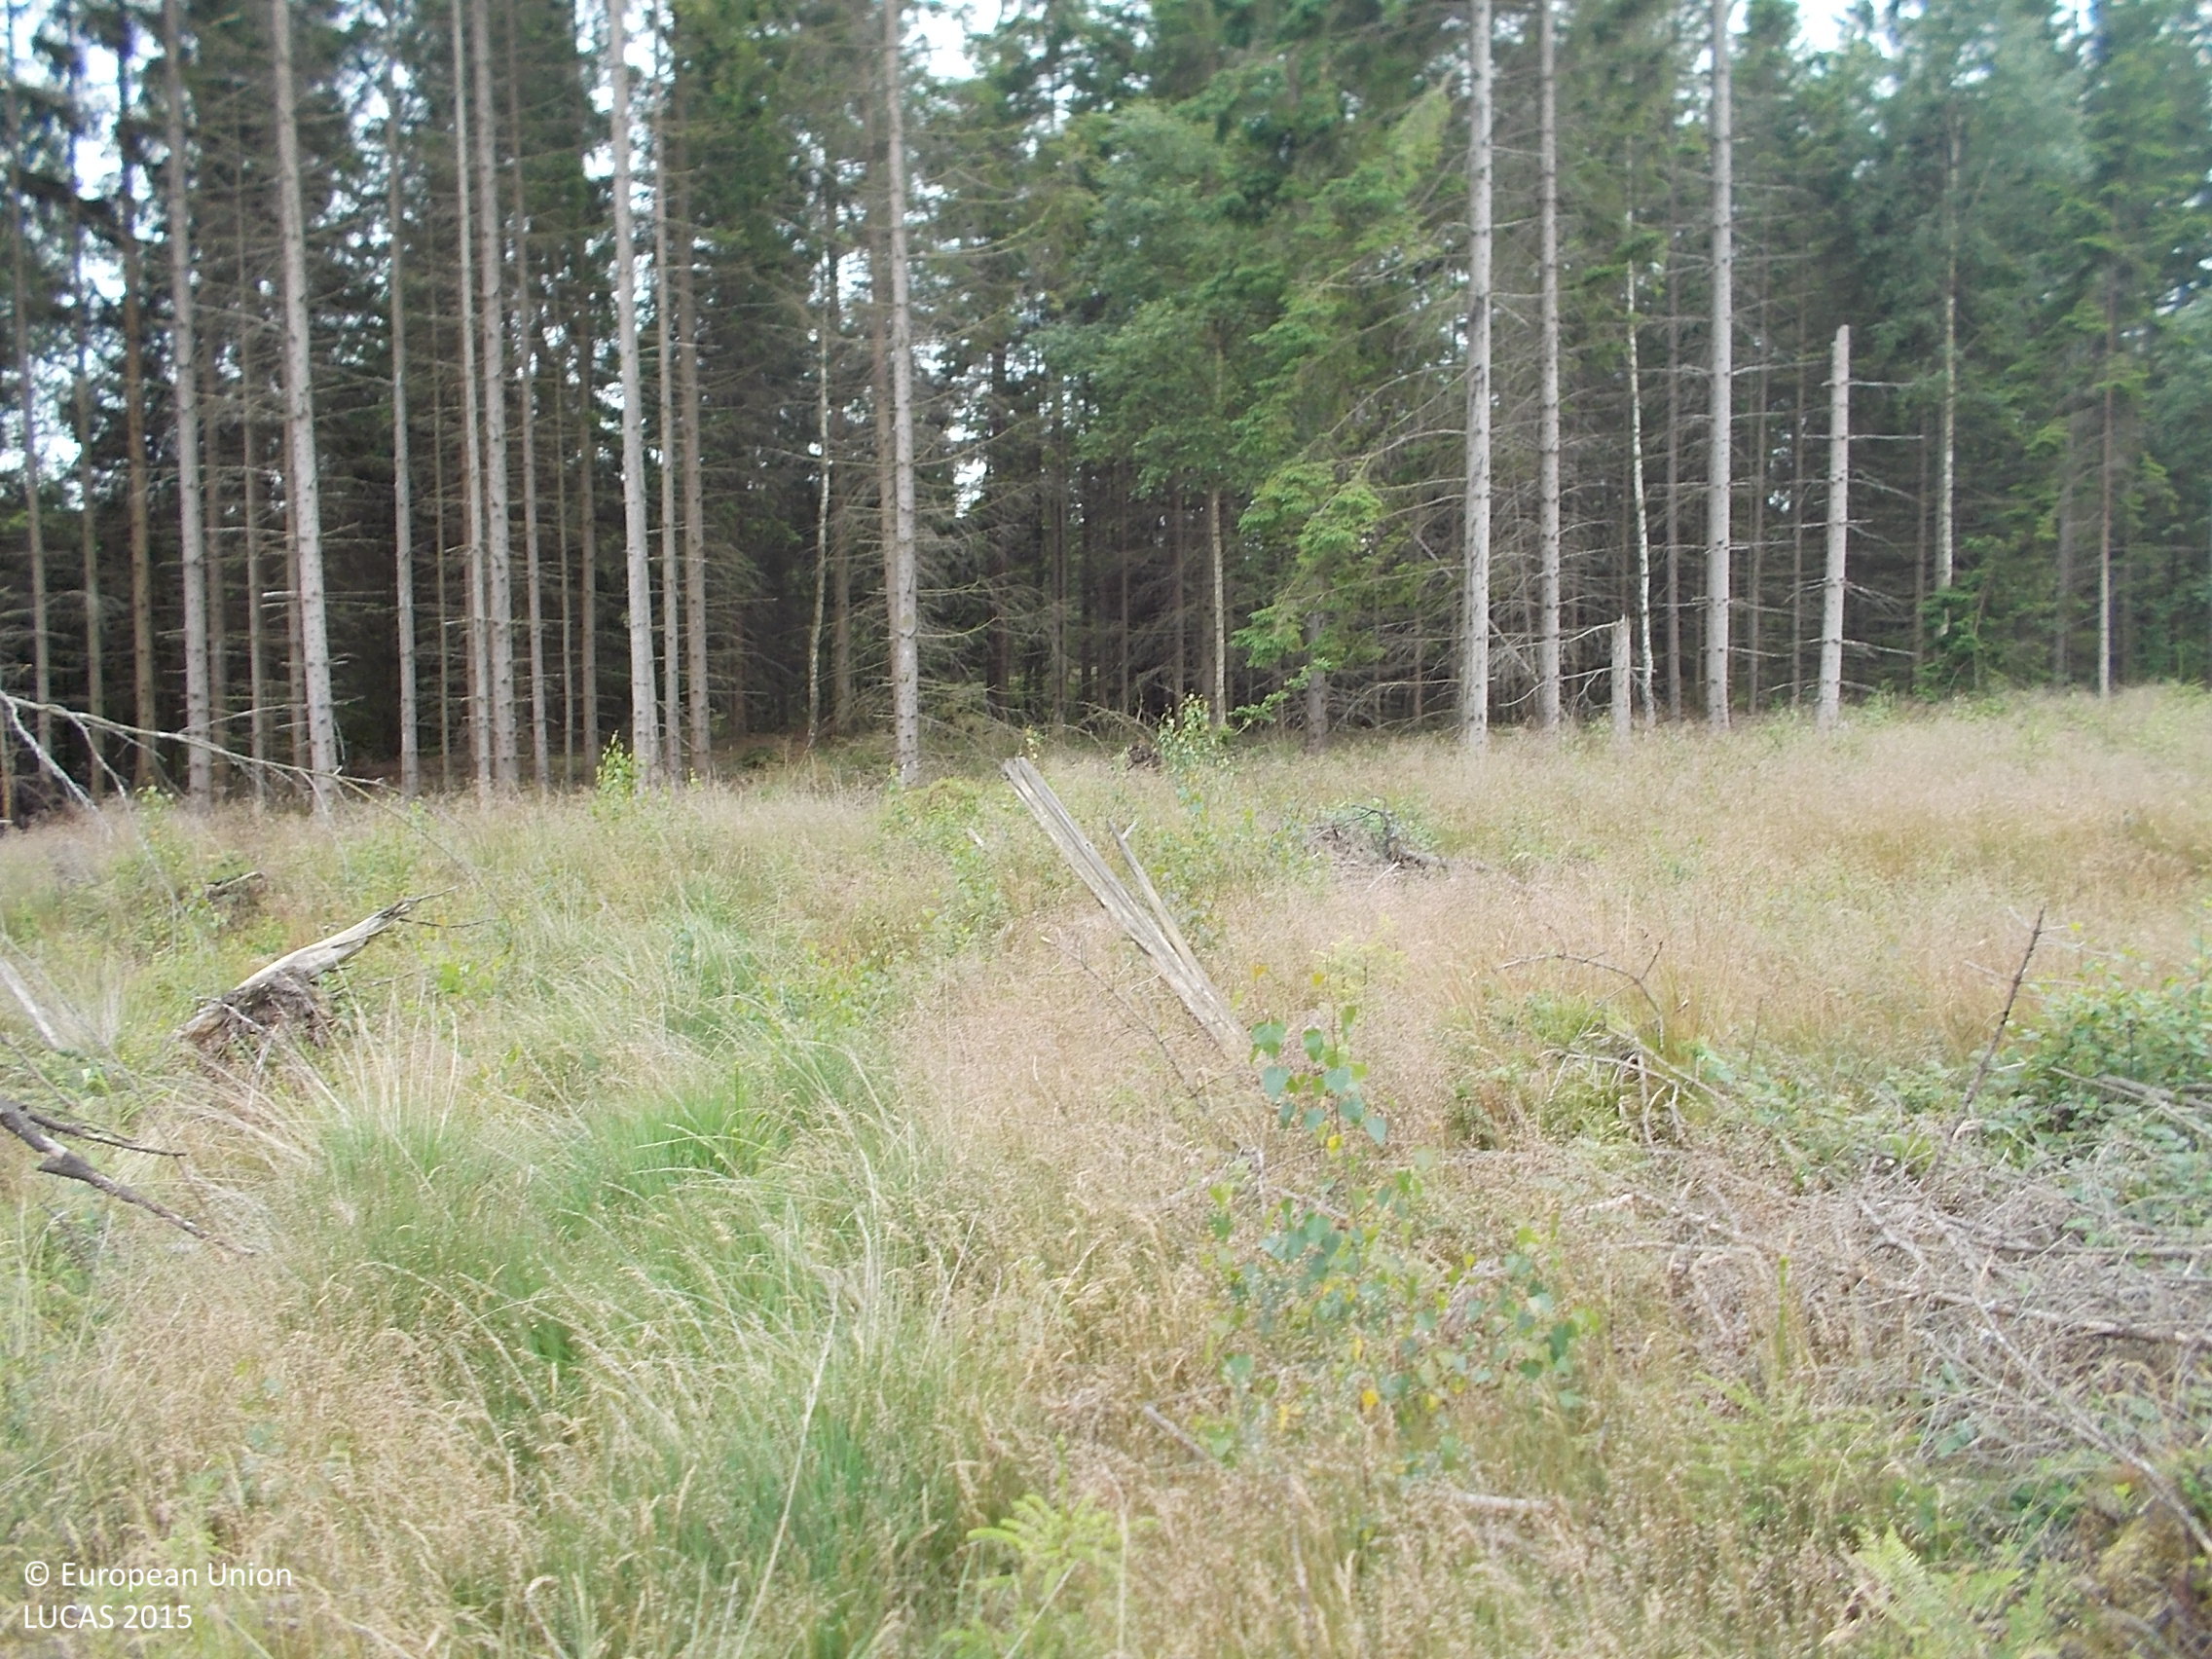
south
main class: Grassland
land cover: Grassland with sparse tree/shrub cover
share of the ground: > 75 %
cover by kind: herbaceous plants 75 %, coniferous forest trees 5 %, shrubs 5 %, lichens and mosses 5 %, unconsolidated bare surface 5 %
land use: Forestry
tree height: < 5 m
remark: Clear cut
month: July
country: SE
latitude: 57.2649
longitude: 12.2683
